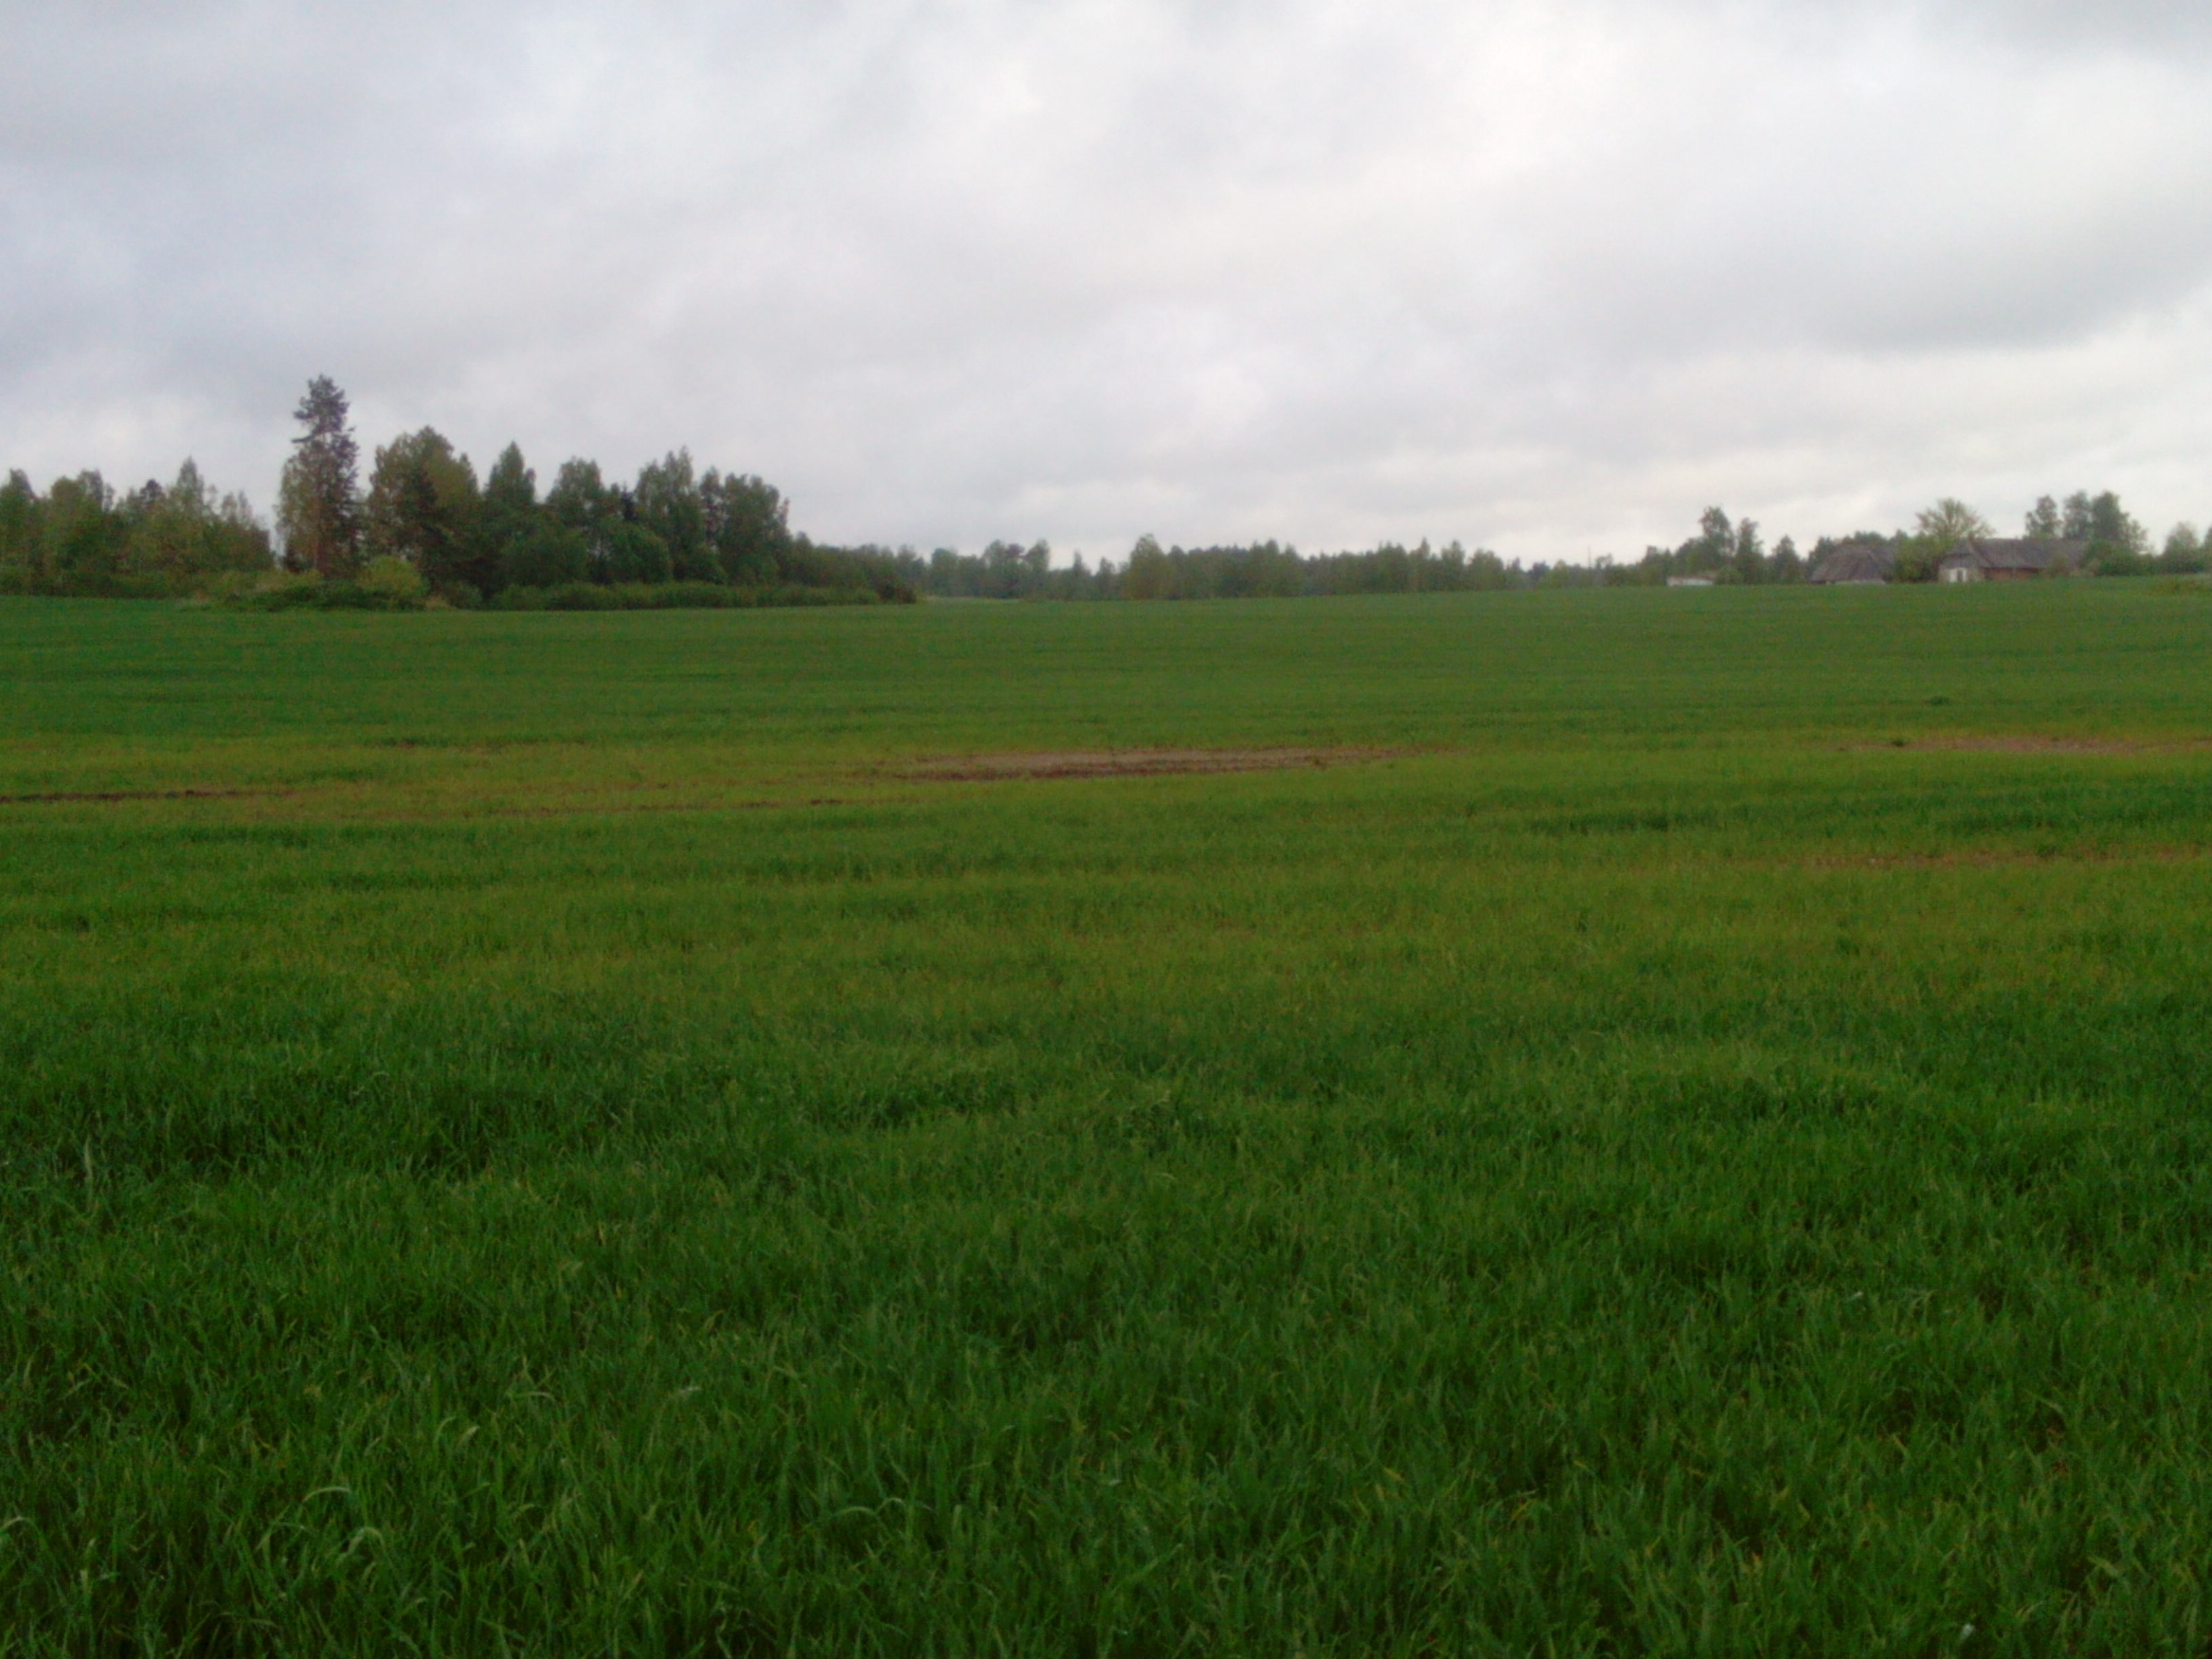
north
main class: Cropland
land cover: Common wheat
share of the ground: > 75 %
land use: Agriculture (excluding fallow land and kitchen gardens)
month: May
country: LV
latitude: 56.7677
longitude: 22.7730
